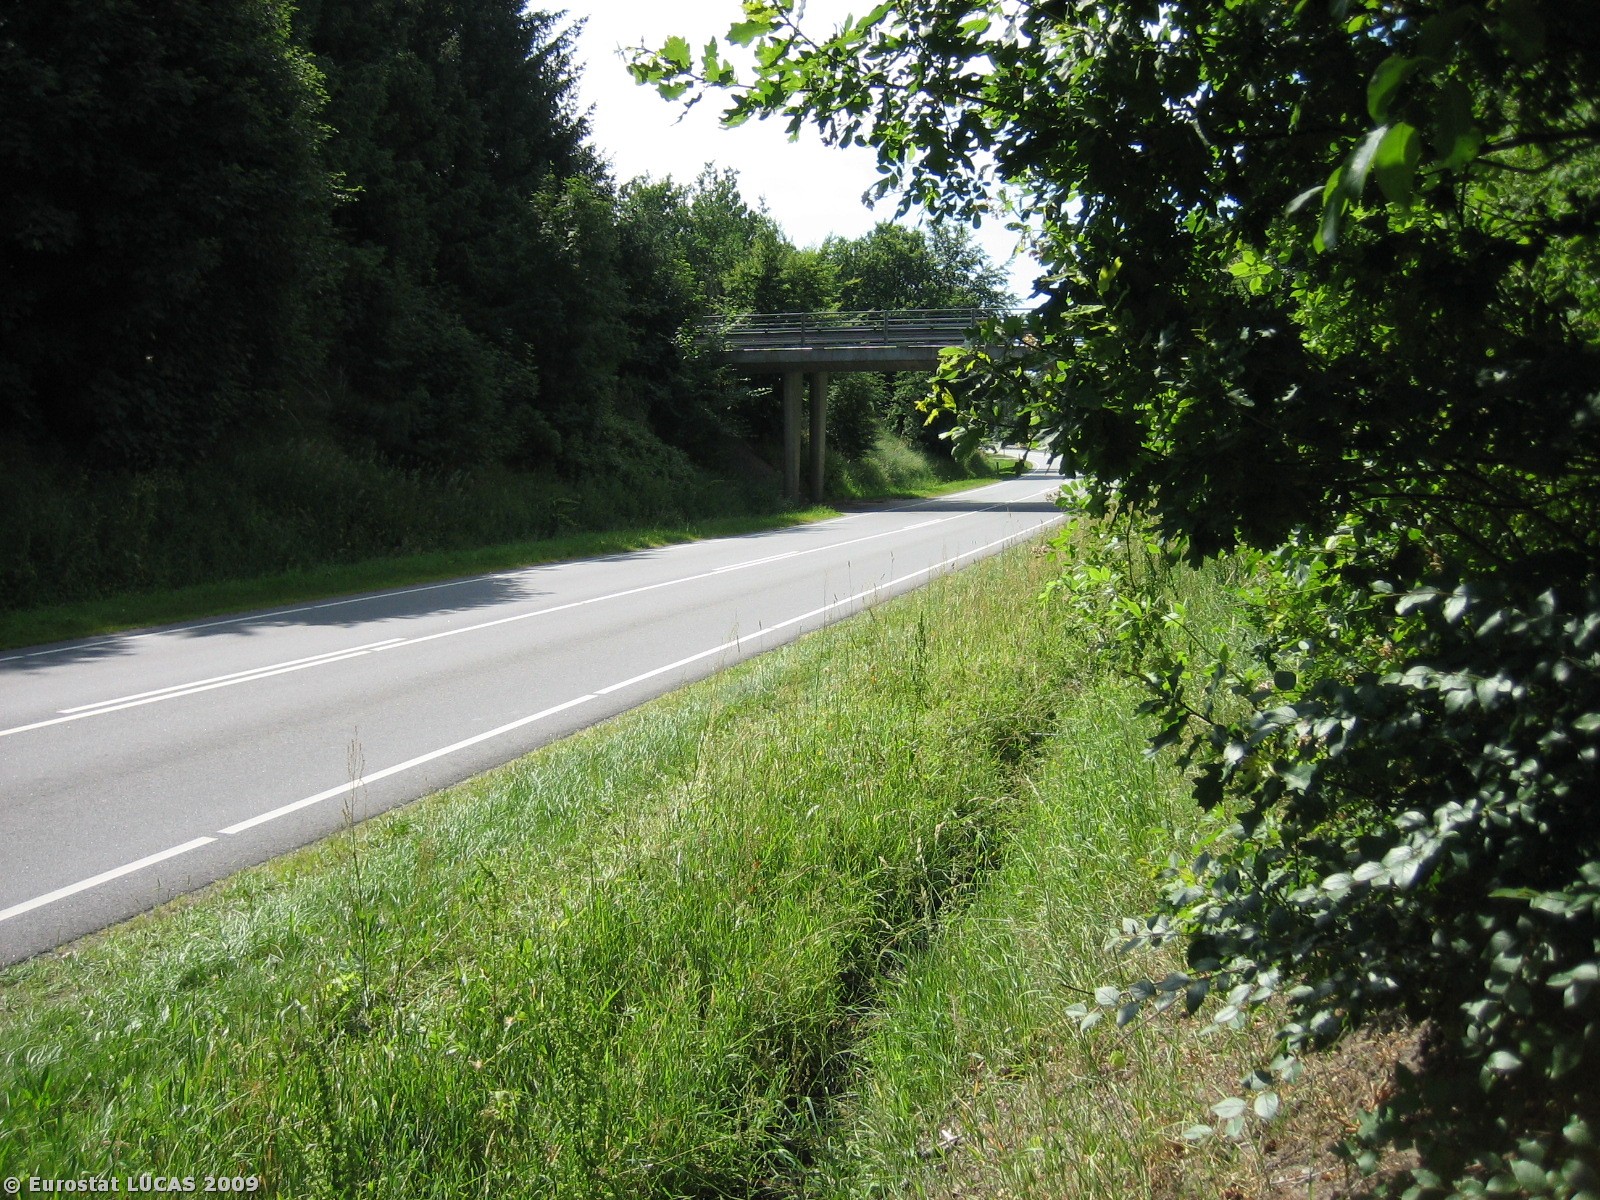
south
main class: Woodland
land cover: Broadleaved woodland
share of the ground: > 75 %
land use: Unused
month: July
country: DK
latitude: 55.6081
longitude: 8.9374
